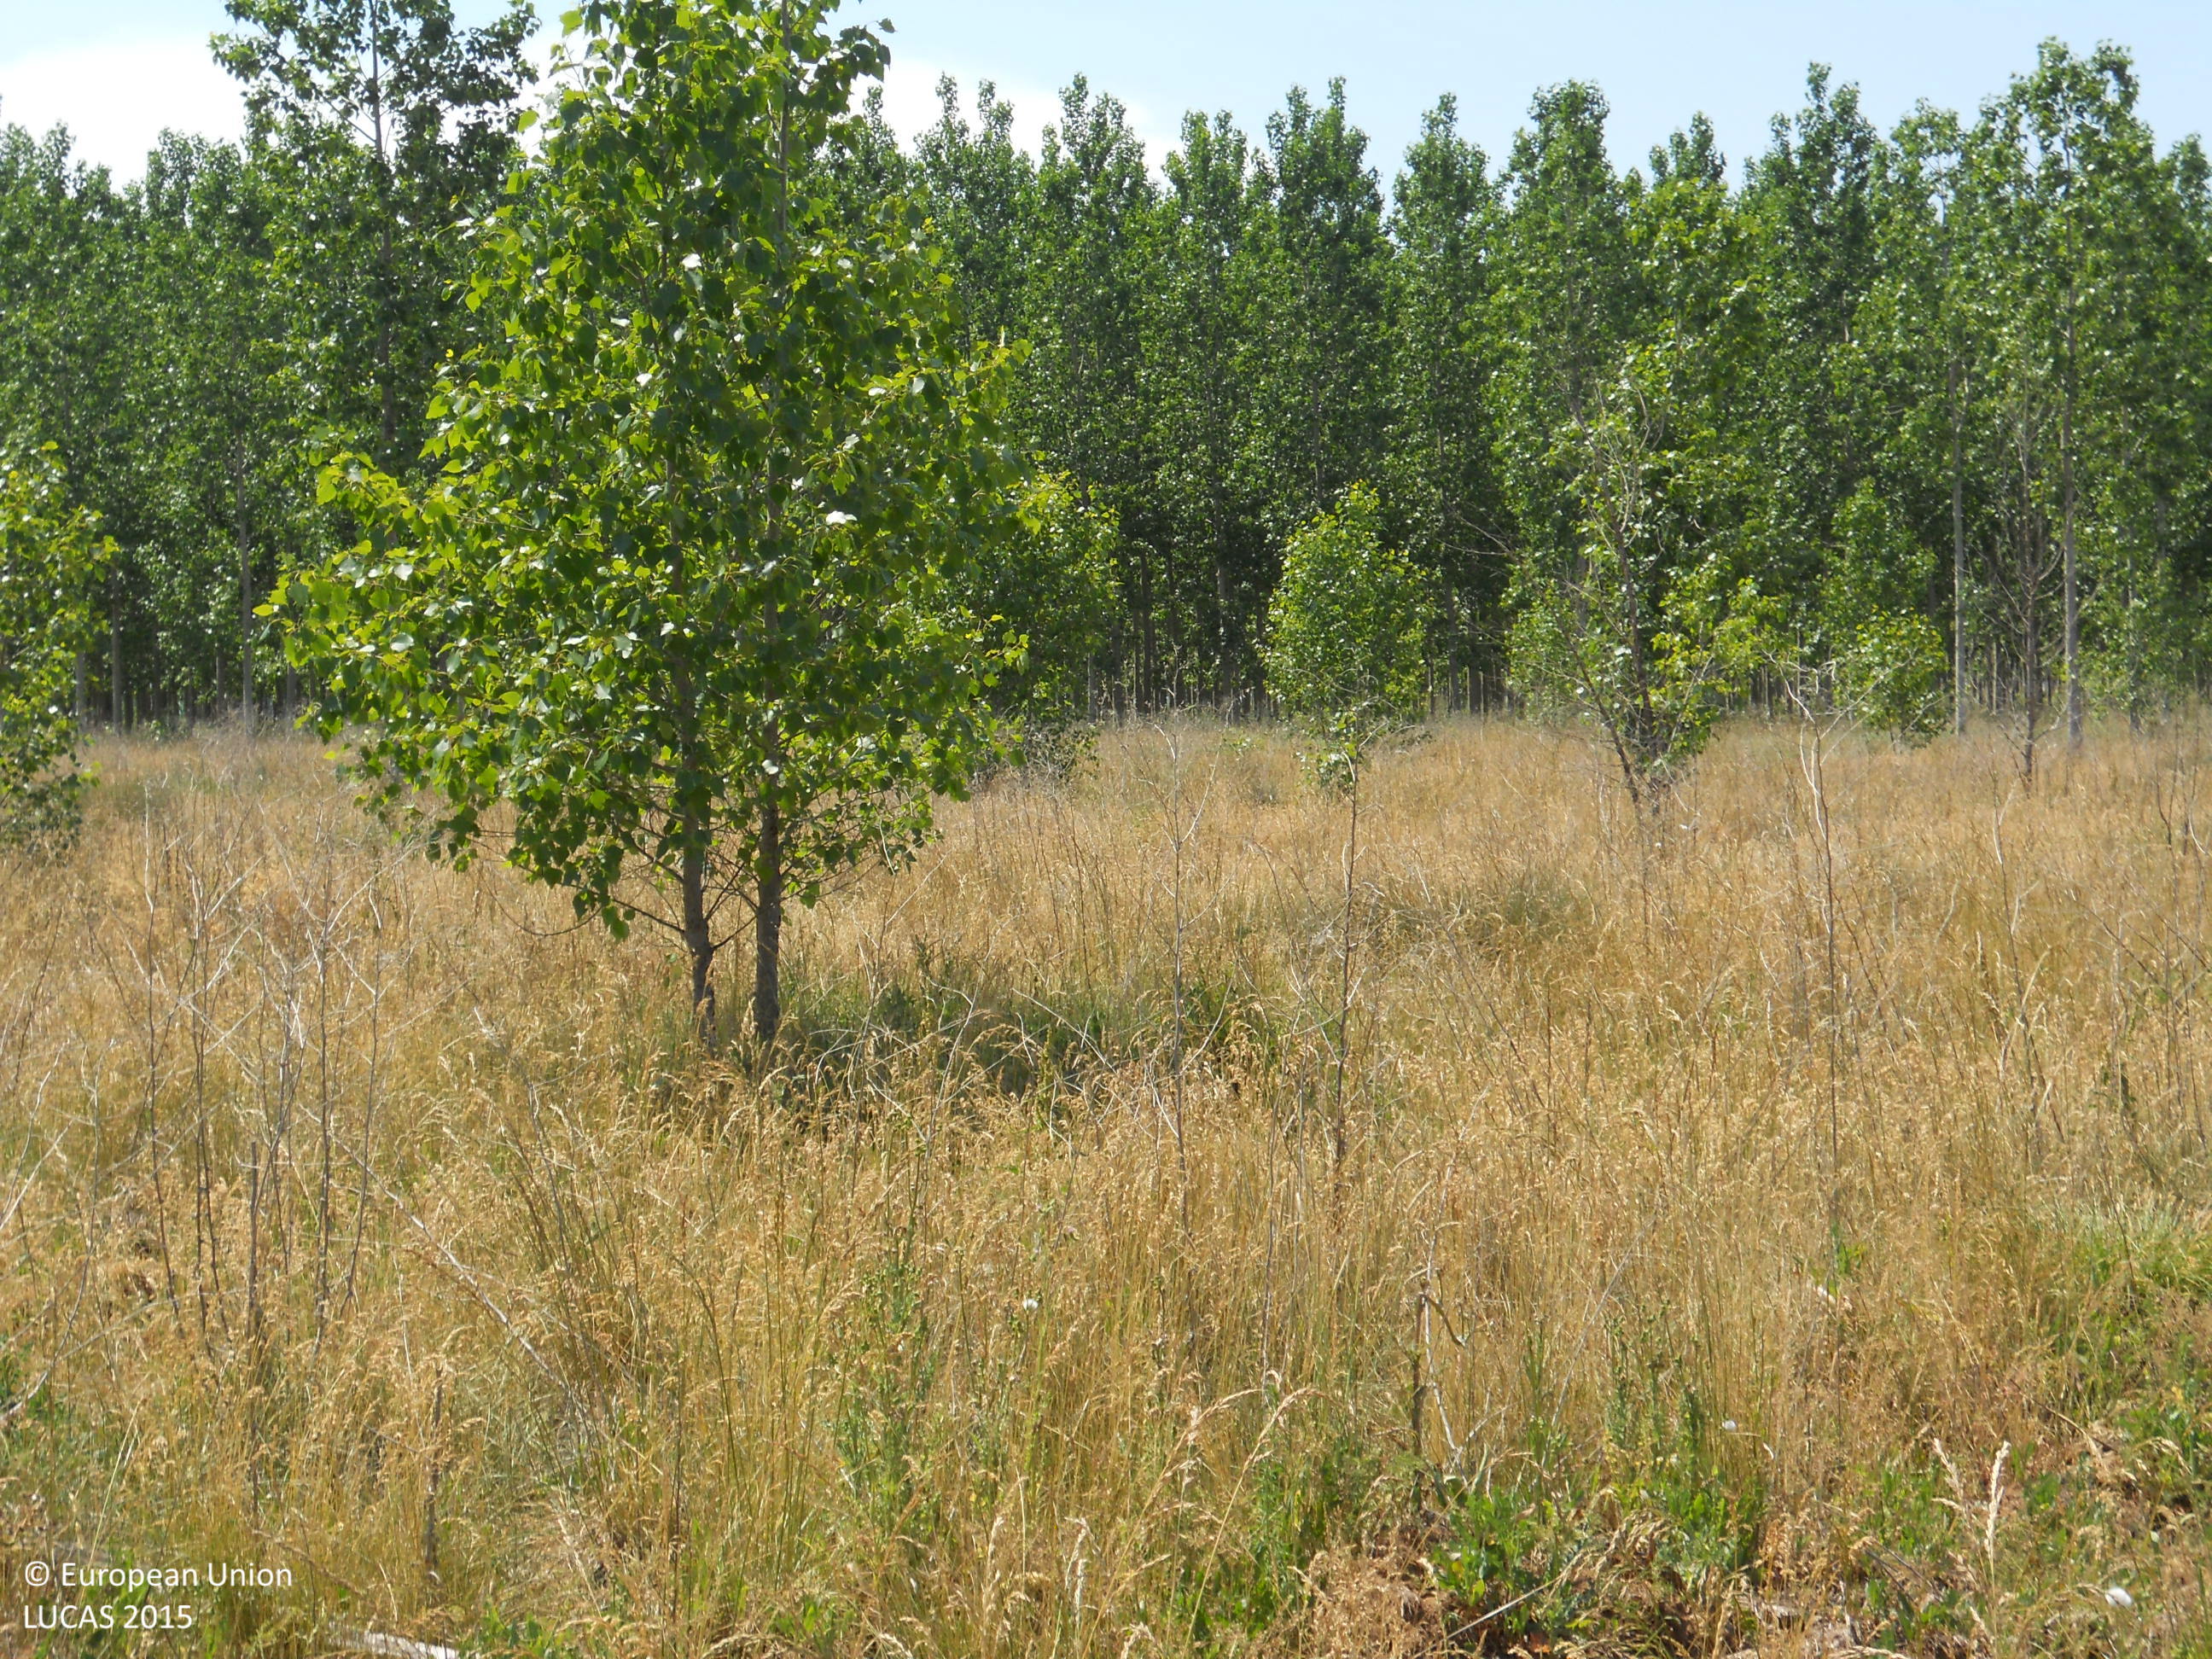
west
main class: Woodland
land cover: Broadleaved woodland
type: exotic forest
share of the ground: 10 - 25 %
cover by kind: herbaceous plants 90 %, broadleaved forest trees 10 %
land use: Forestry
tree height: > 5 m
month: June
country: ES
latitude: 42.3437
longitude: -5.6695
